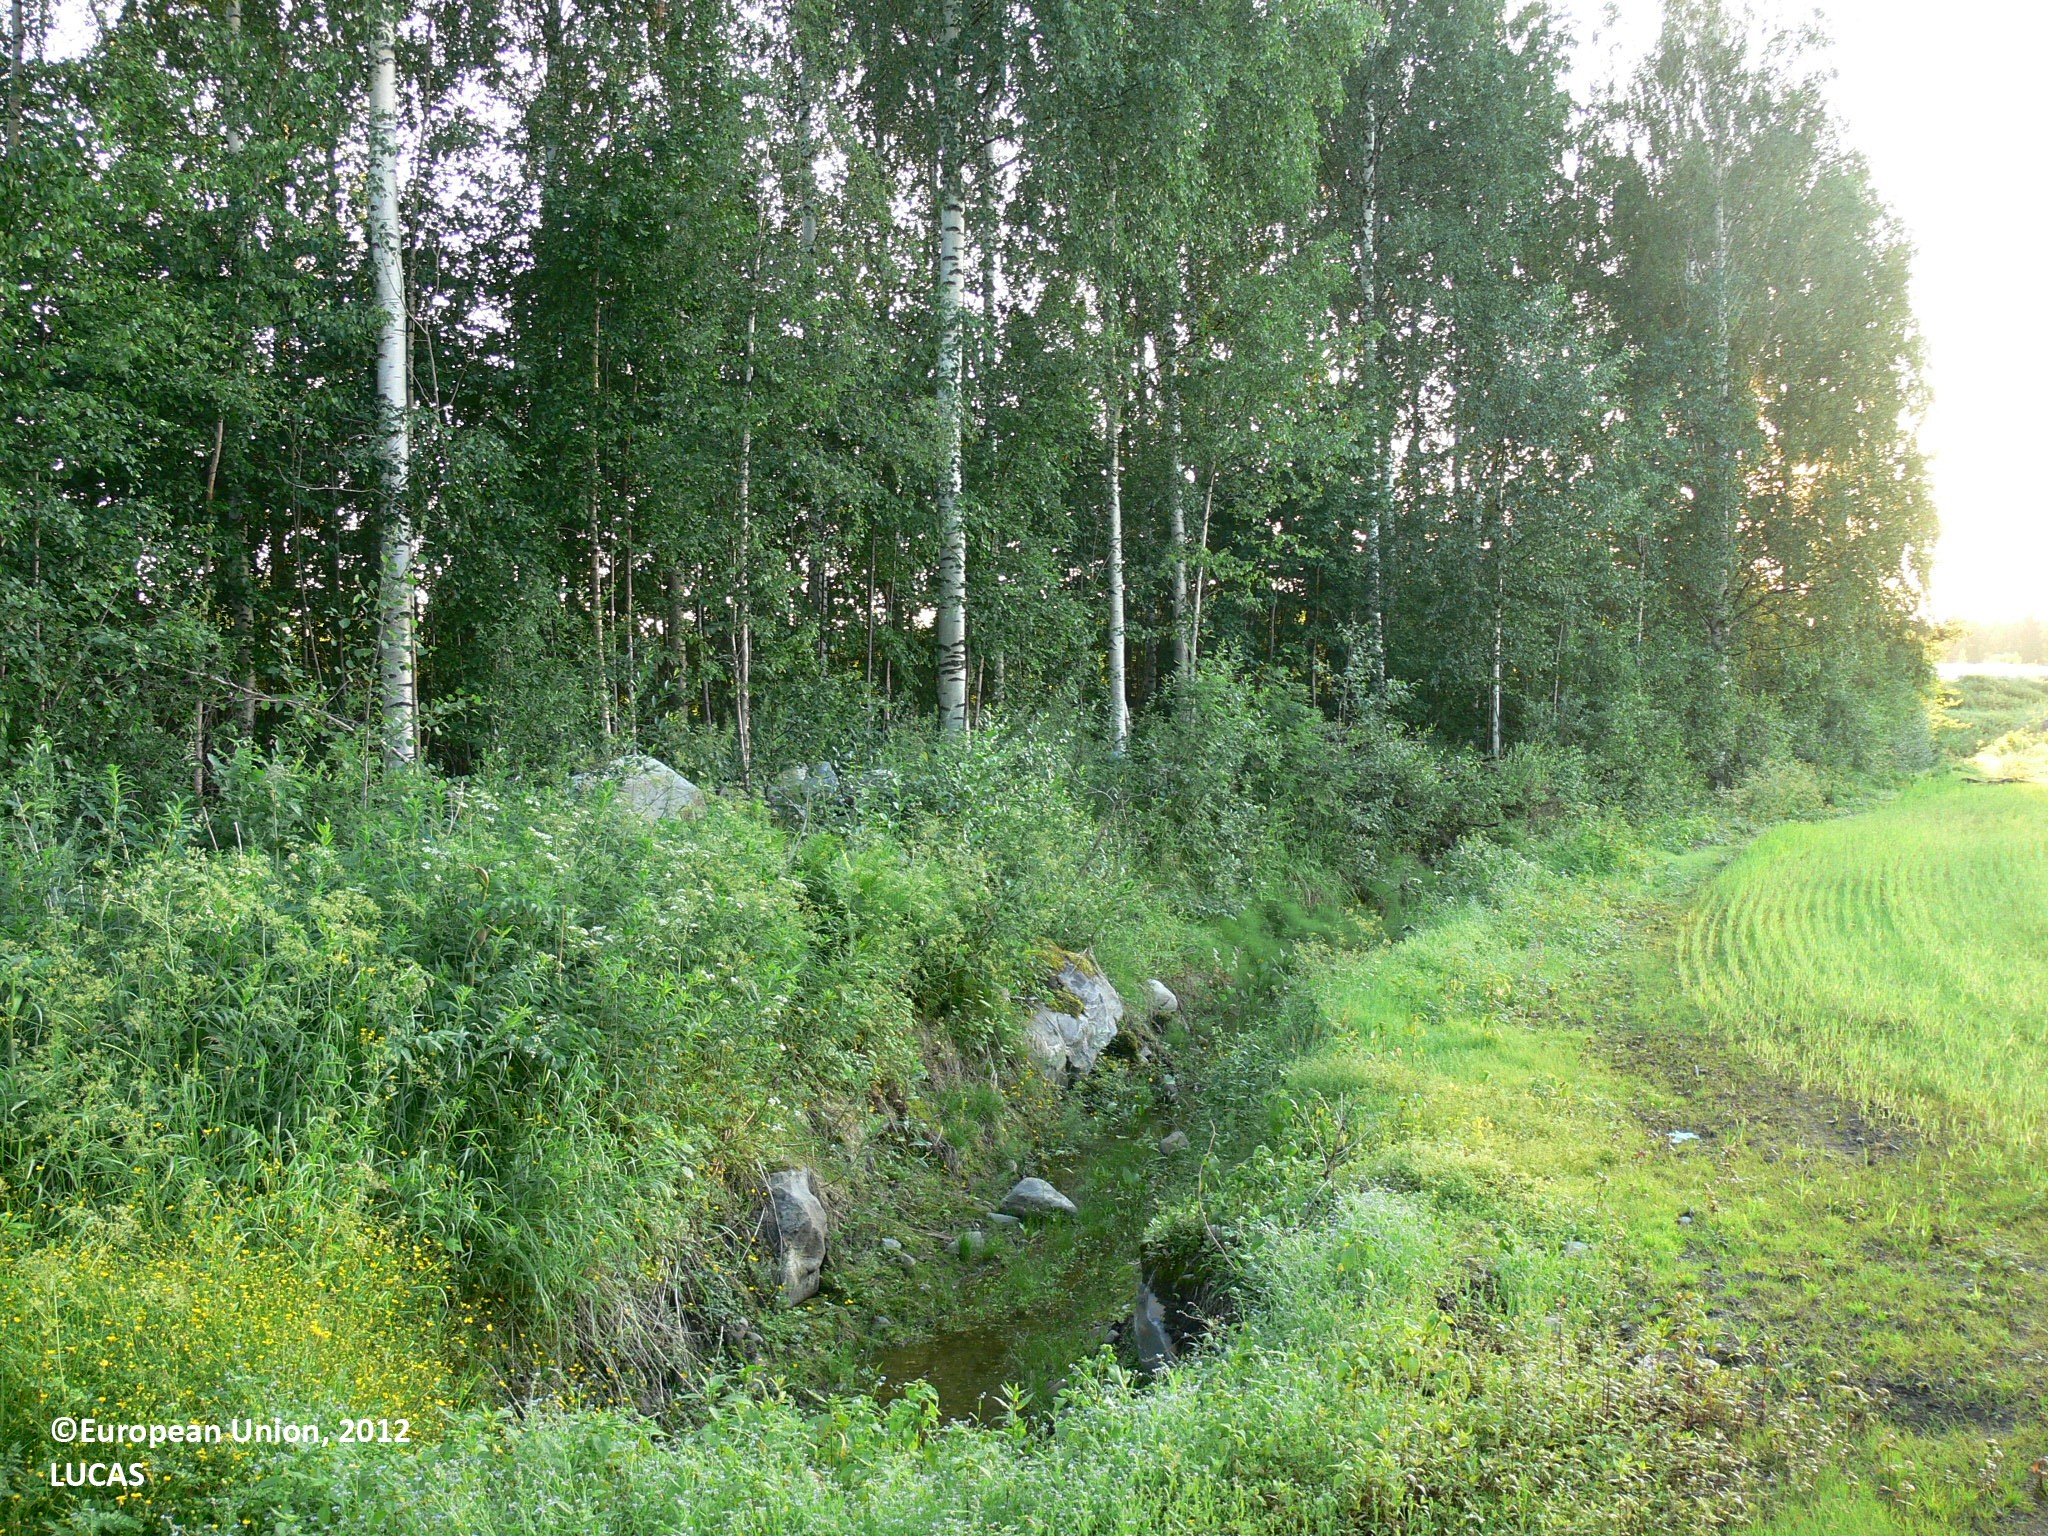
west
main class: Cropland
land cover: Barley
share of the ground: > 75 %
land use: Agriculture (excluding fallow land and kitchen gardens)
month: July
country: FI
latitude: 62.2902
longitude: 29.6207
